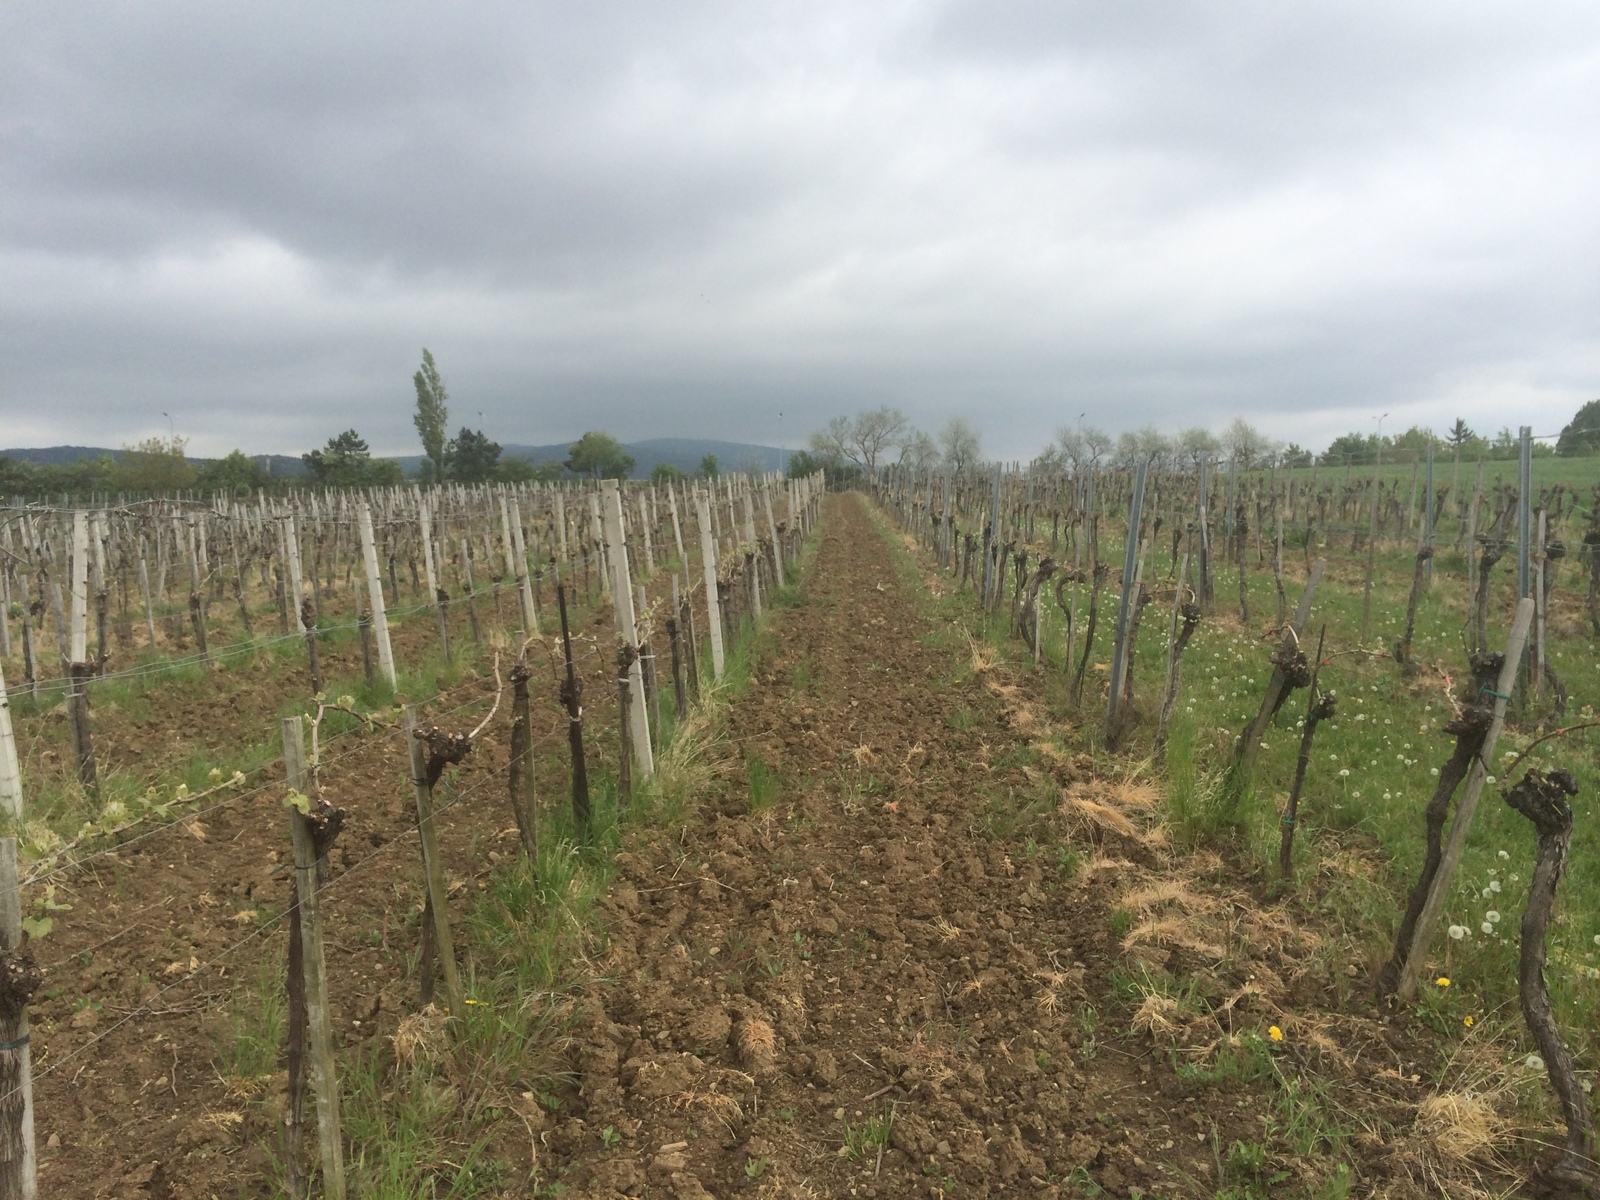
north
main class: Cropland
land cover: Vineyards
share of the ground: 25 - 50 %
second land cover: Spontaneously vegetated surfaces
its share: 50 - 75 %
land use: Agriculture (excluding fallow land and kitchen gardens)
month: May
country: AT
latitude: 47.9929
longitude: 16.2354
